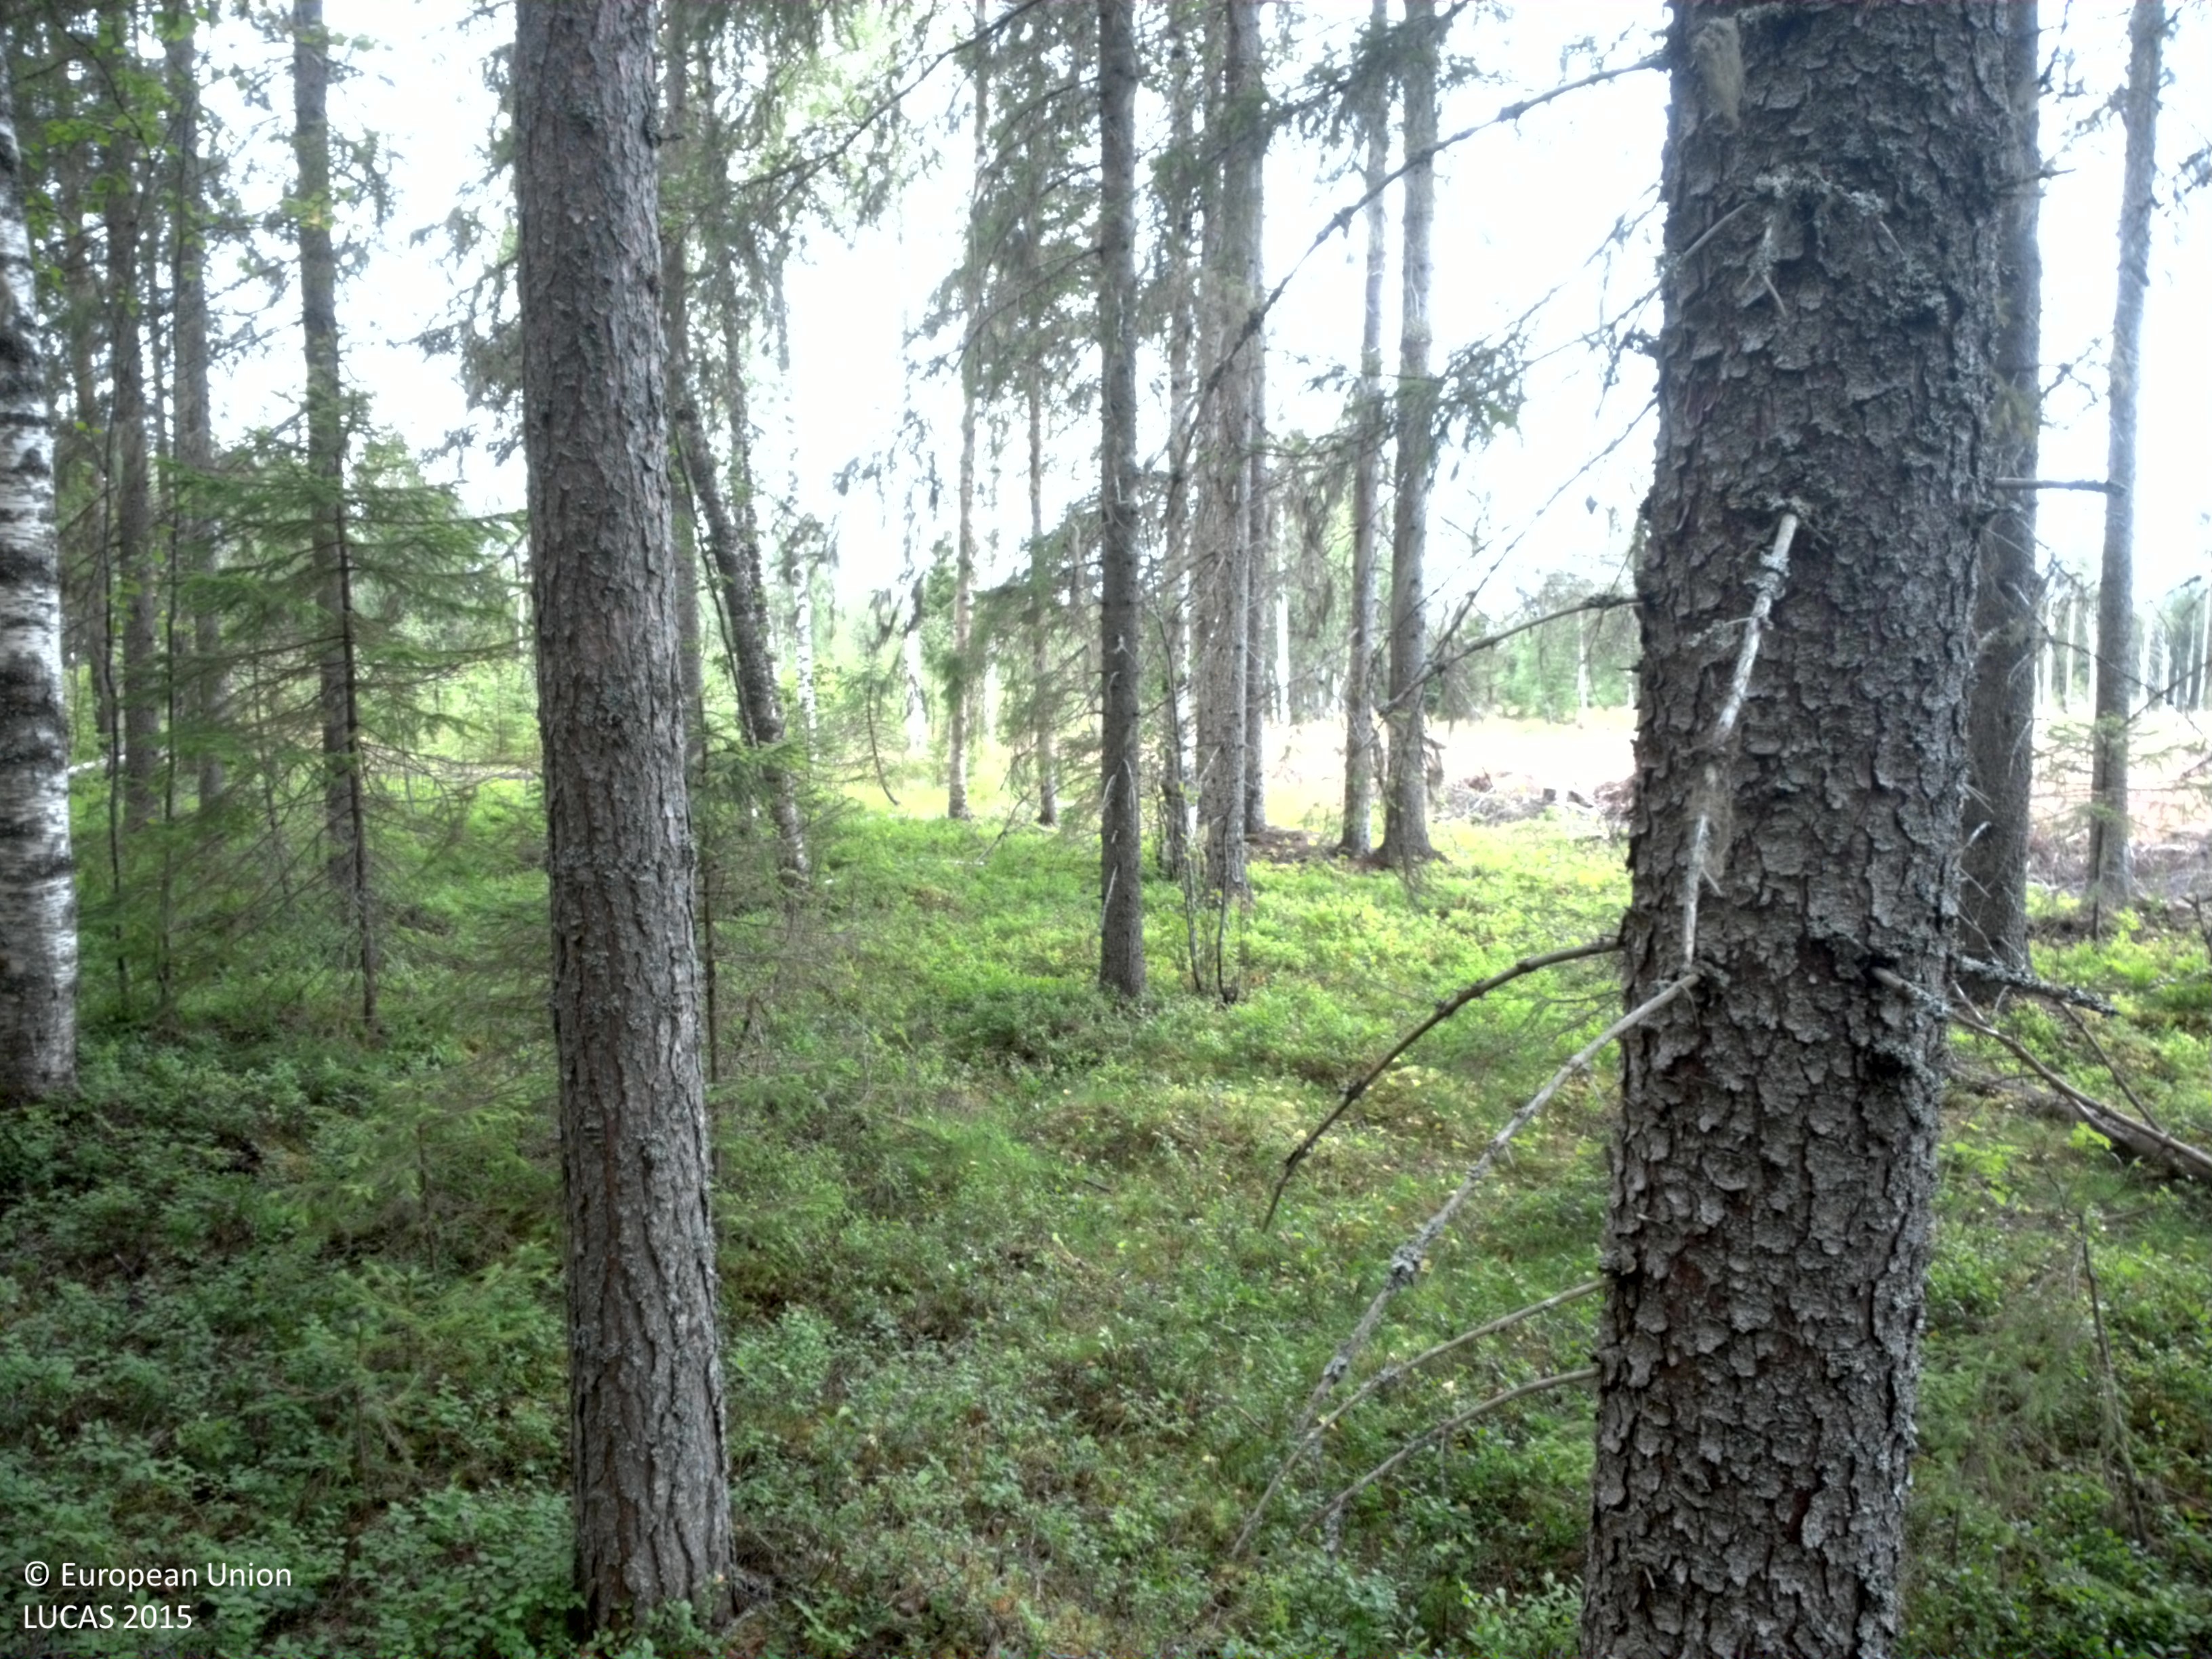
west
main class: Woodland
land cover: Spruce dominated mixed woodland
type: boreal forest
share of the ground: > 75 %
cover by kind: coniferous forest trees 60 %, broadleaved forest trees 20 %, shrubs 20 %
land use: Forestry
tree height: > 5 m
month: August
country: SE
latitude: 64.5402
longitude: 20.7996
